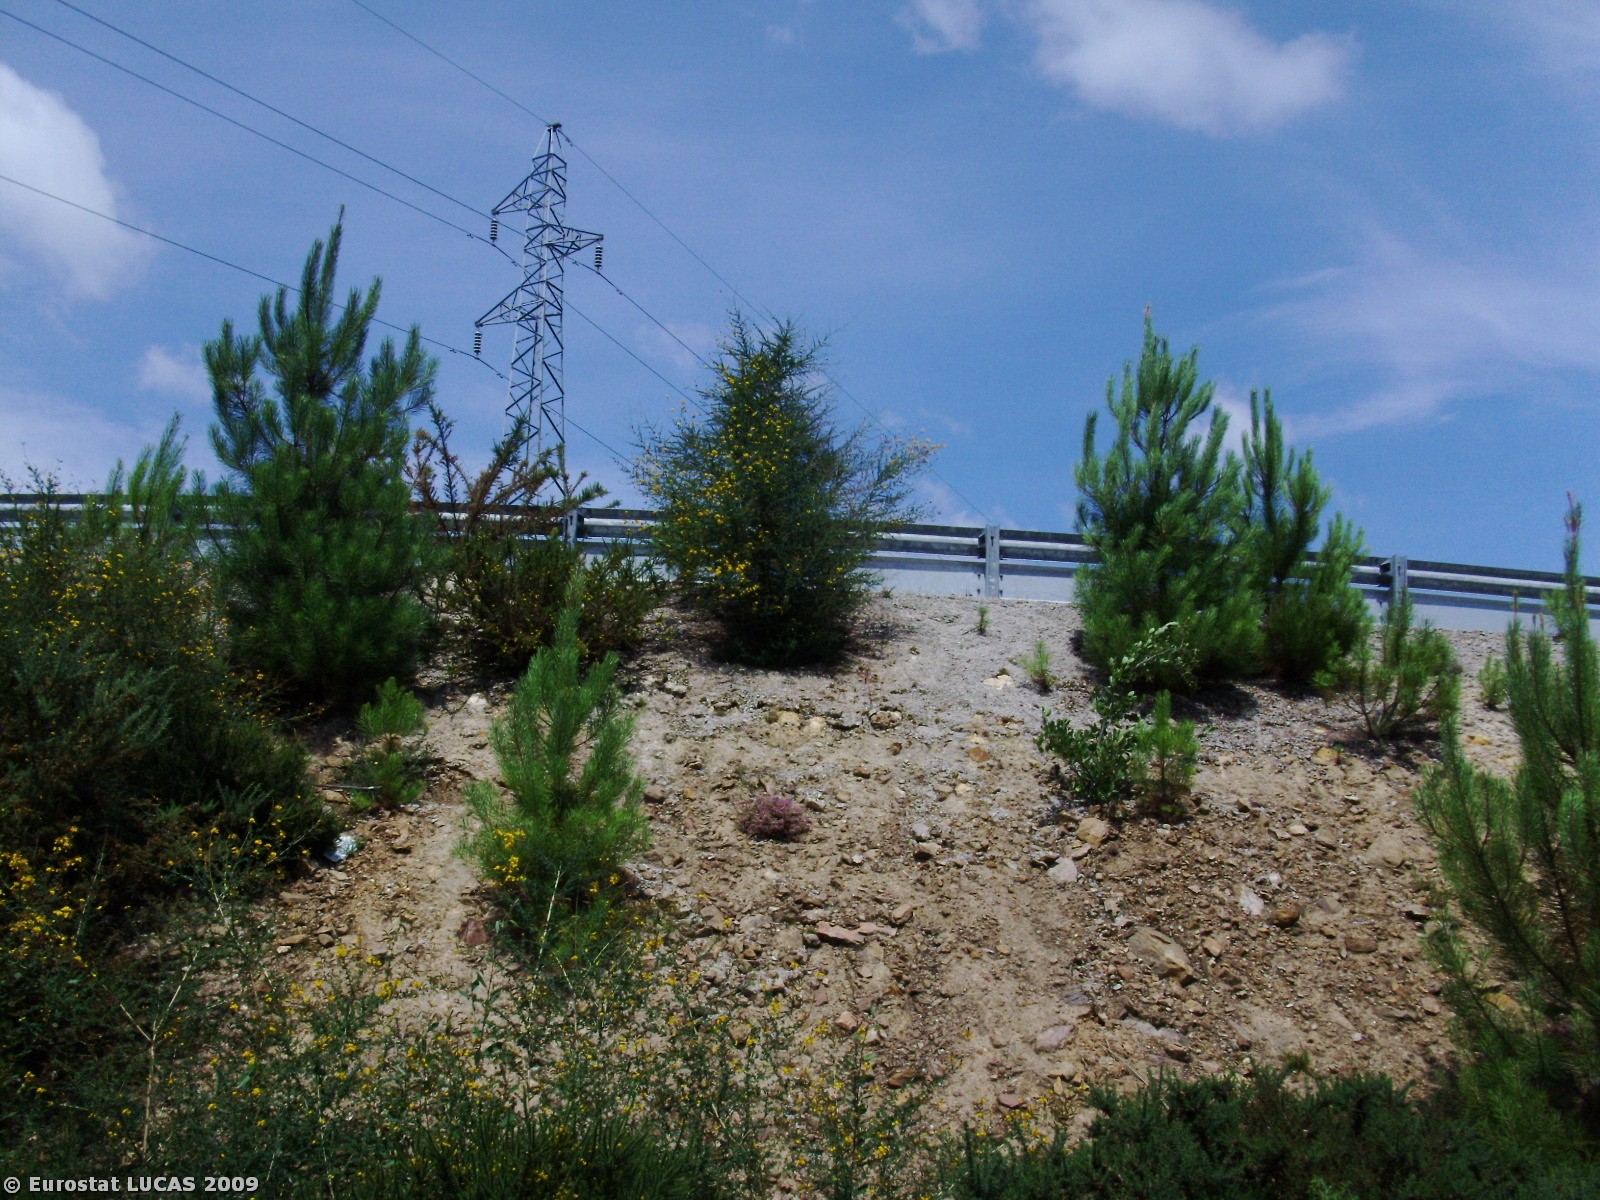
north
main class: Grassland
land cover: Spontaneously vegetated surfaces
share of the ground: 10 - 25 %
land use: Unused
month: June
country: PT
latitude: 41.5272
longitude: -8.5782
